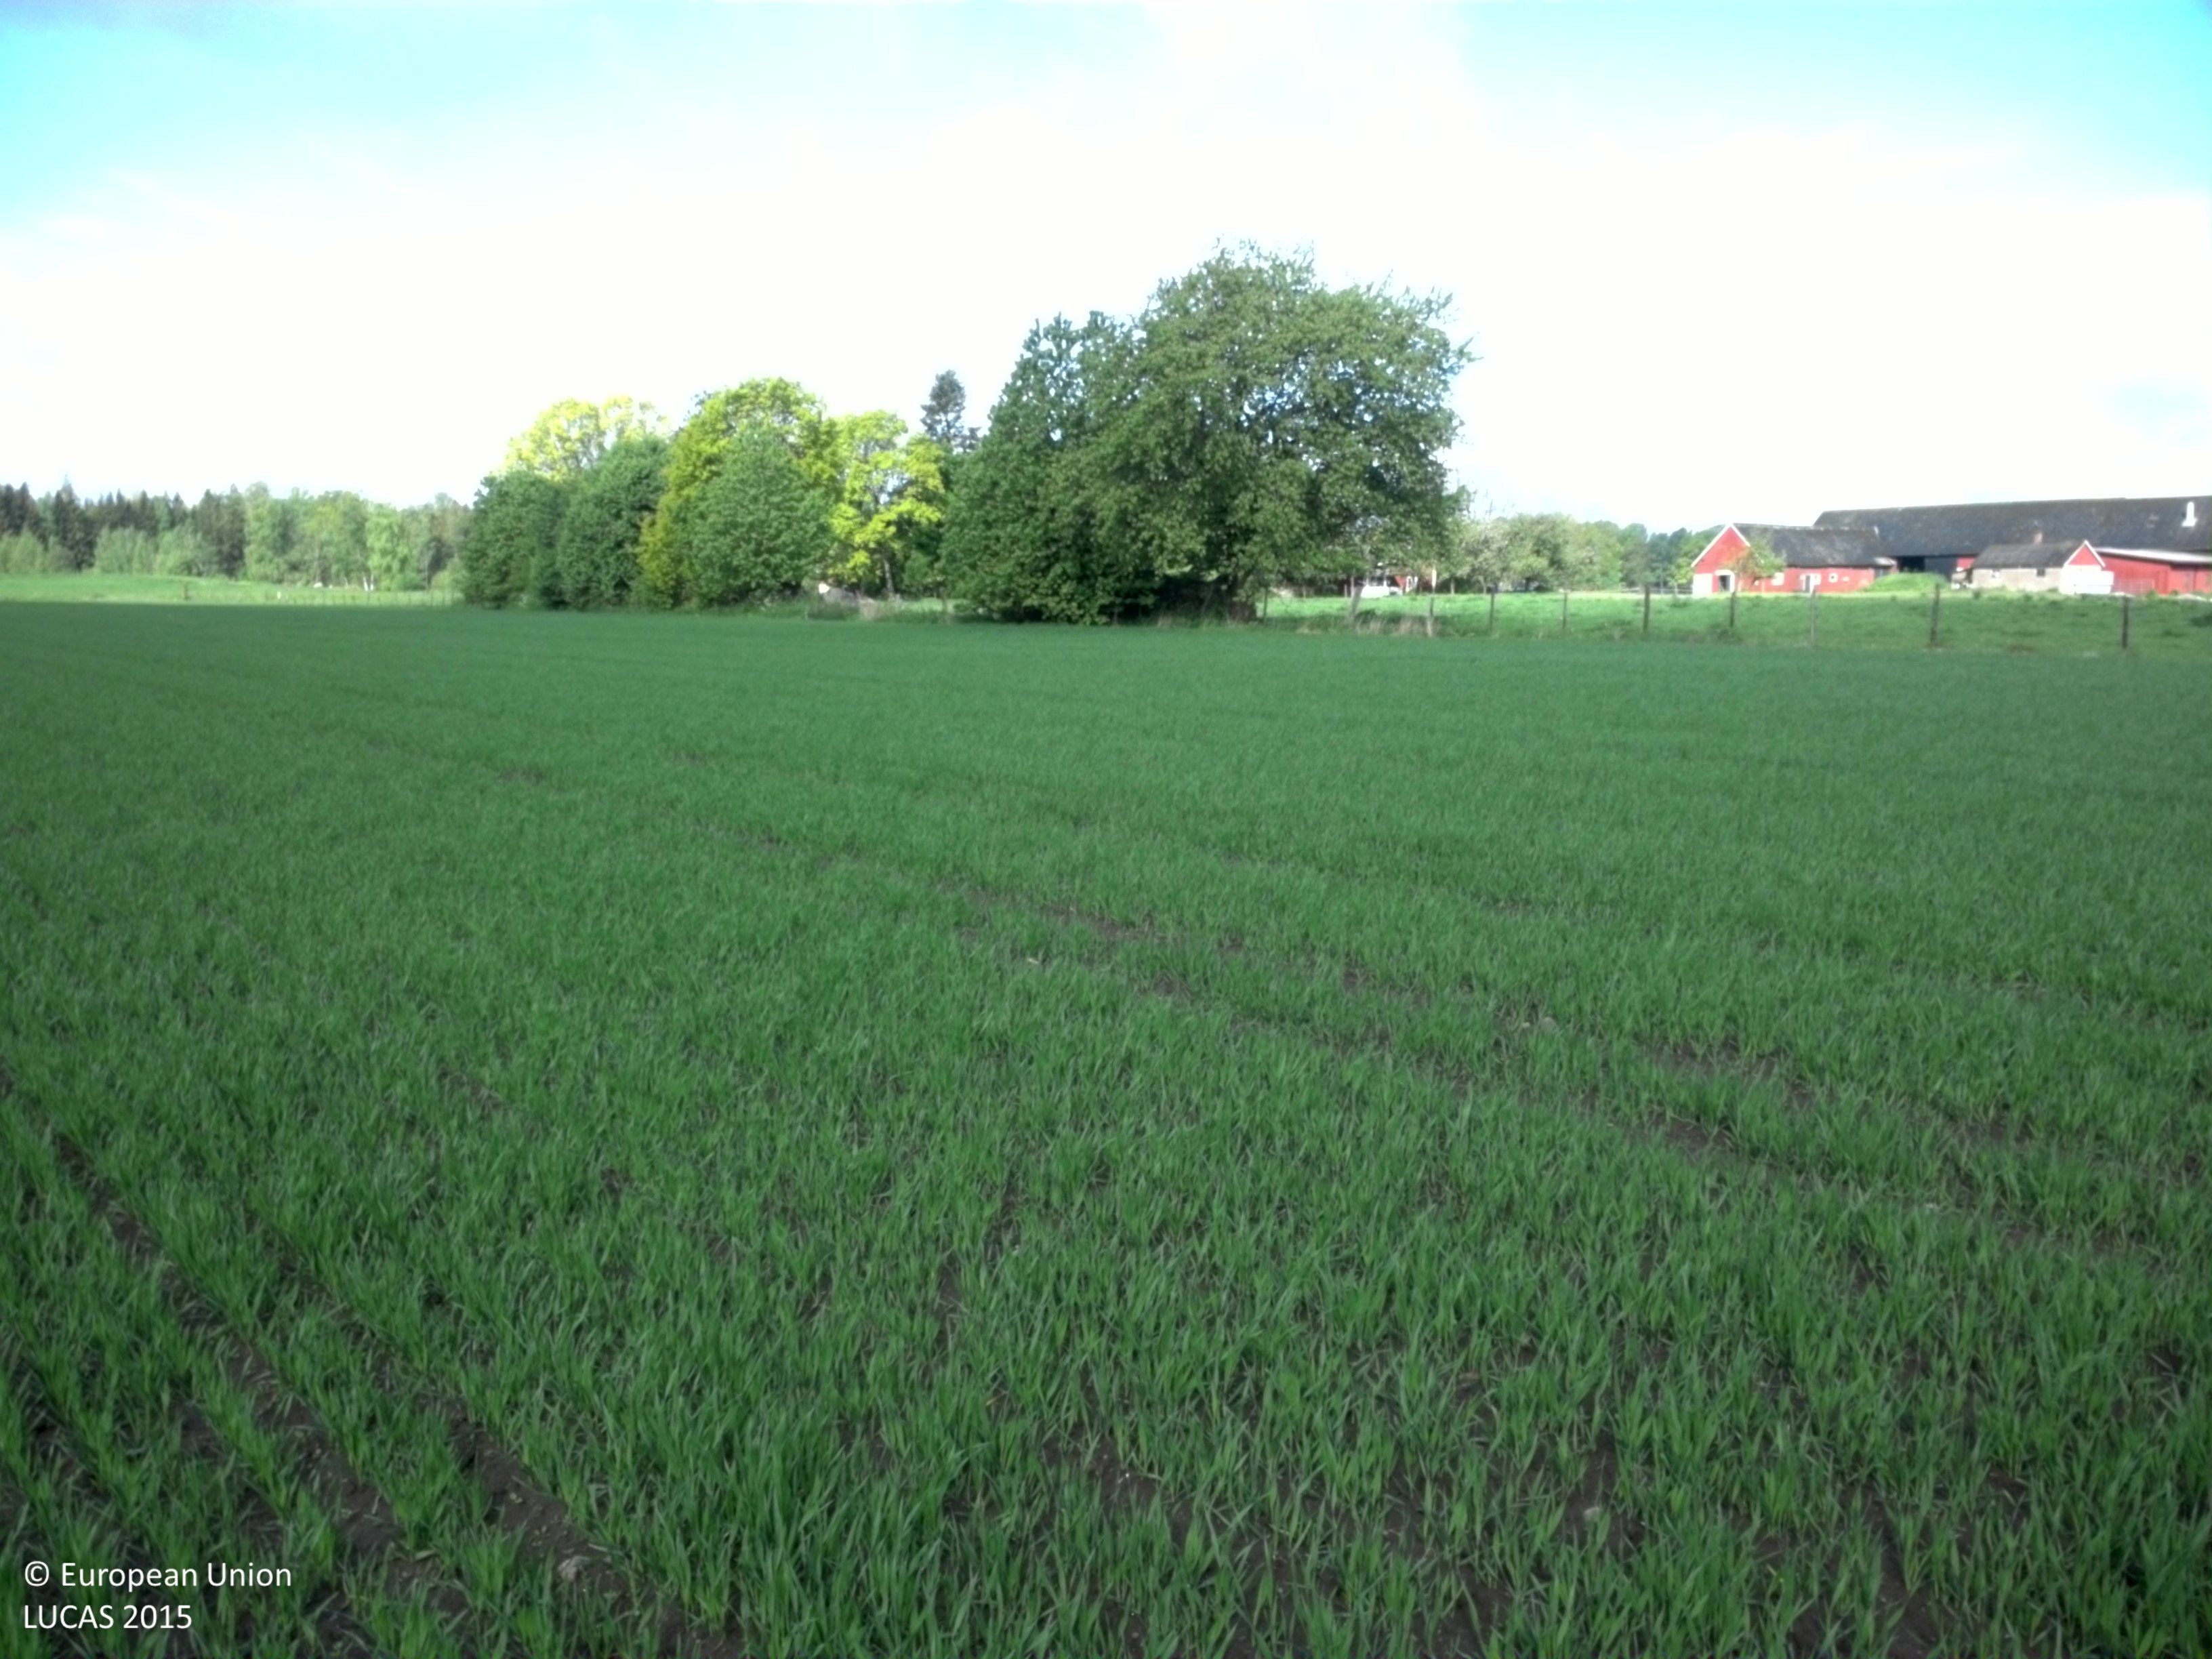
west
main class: Cropland
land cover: Oats
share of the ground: 50 - 75 %
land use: Agriculture (excluding fallow land and kitchen gardens)
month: June
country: SE
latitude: 56.7181
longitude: 14.5885
